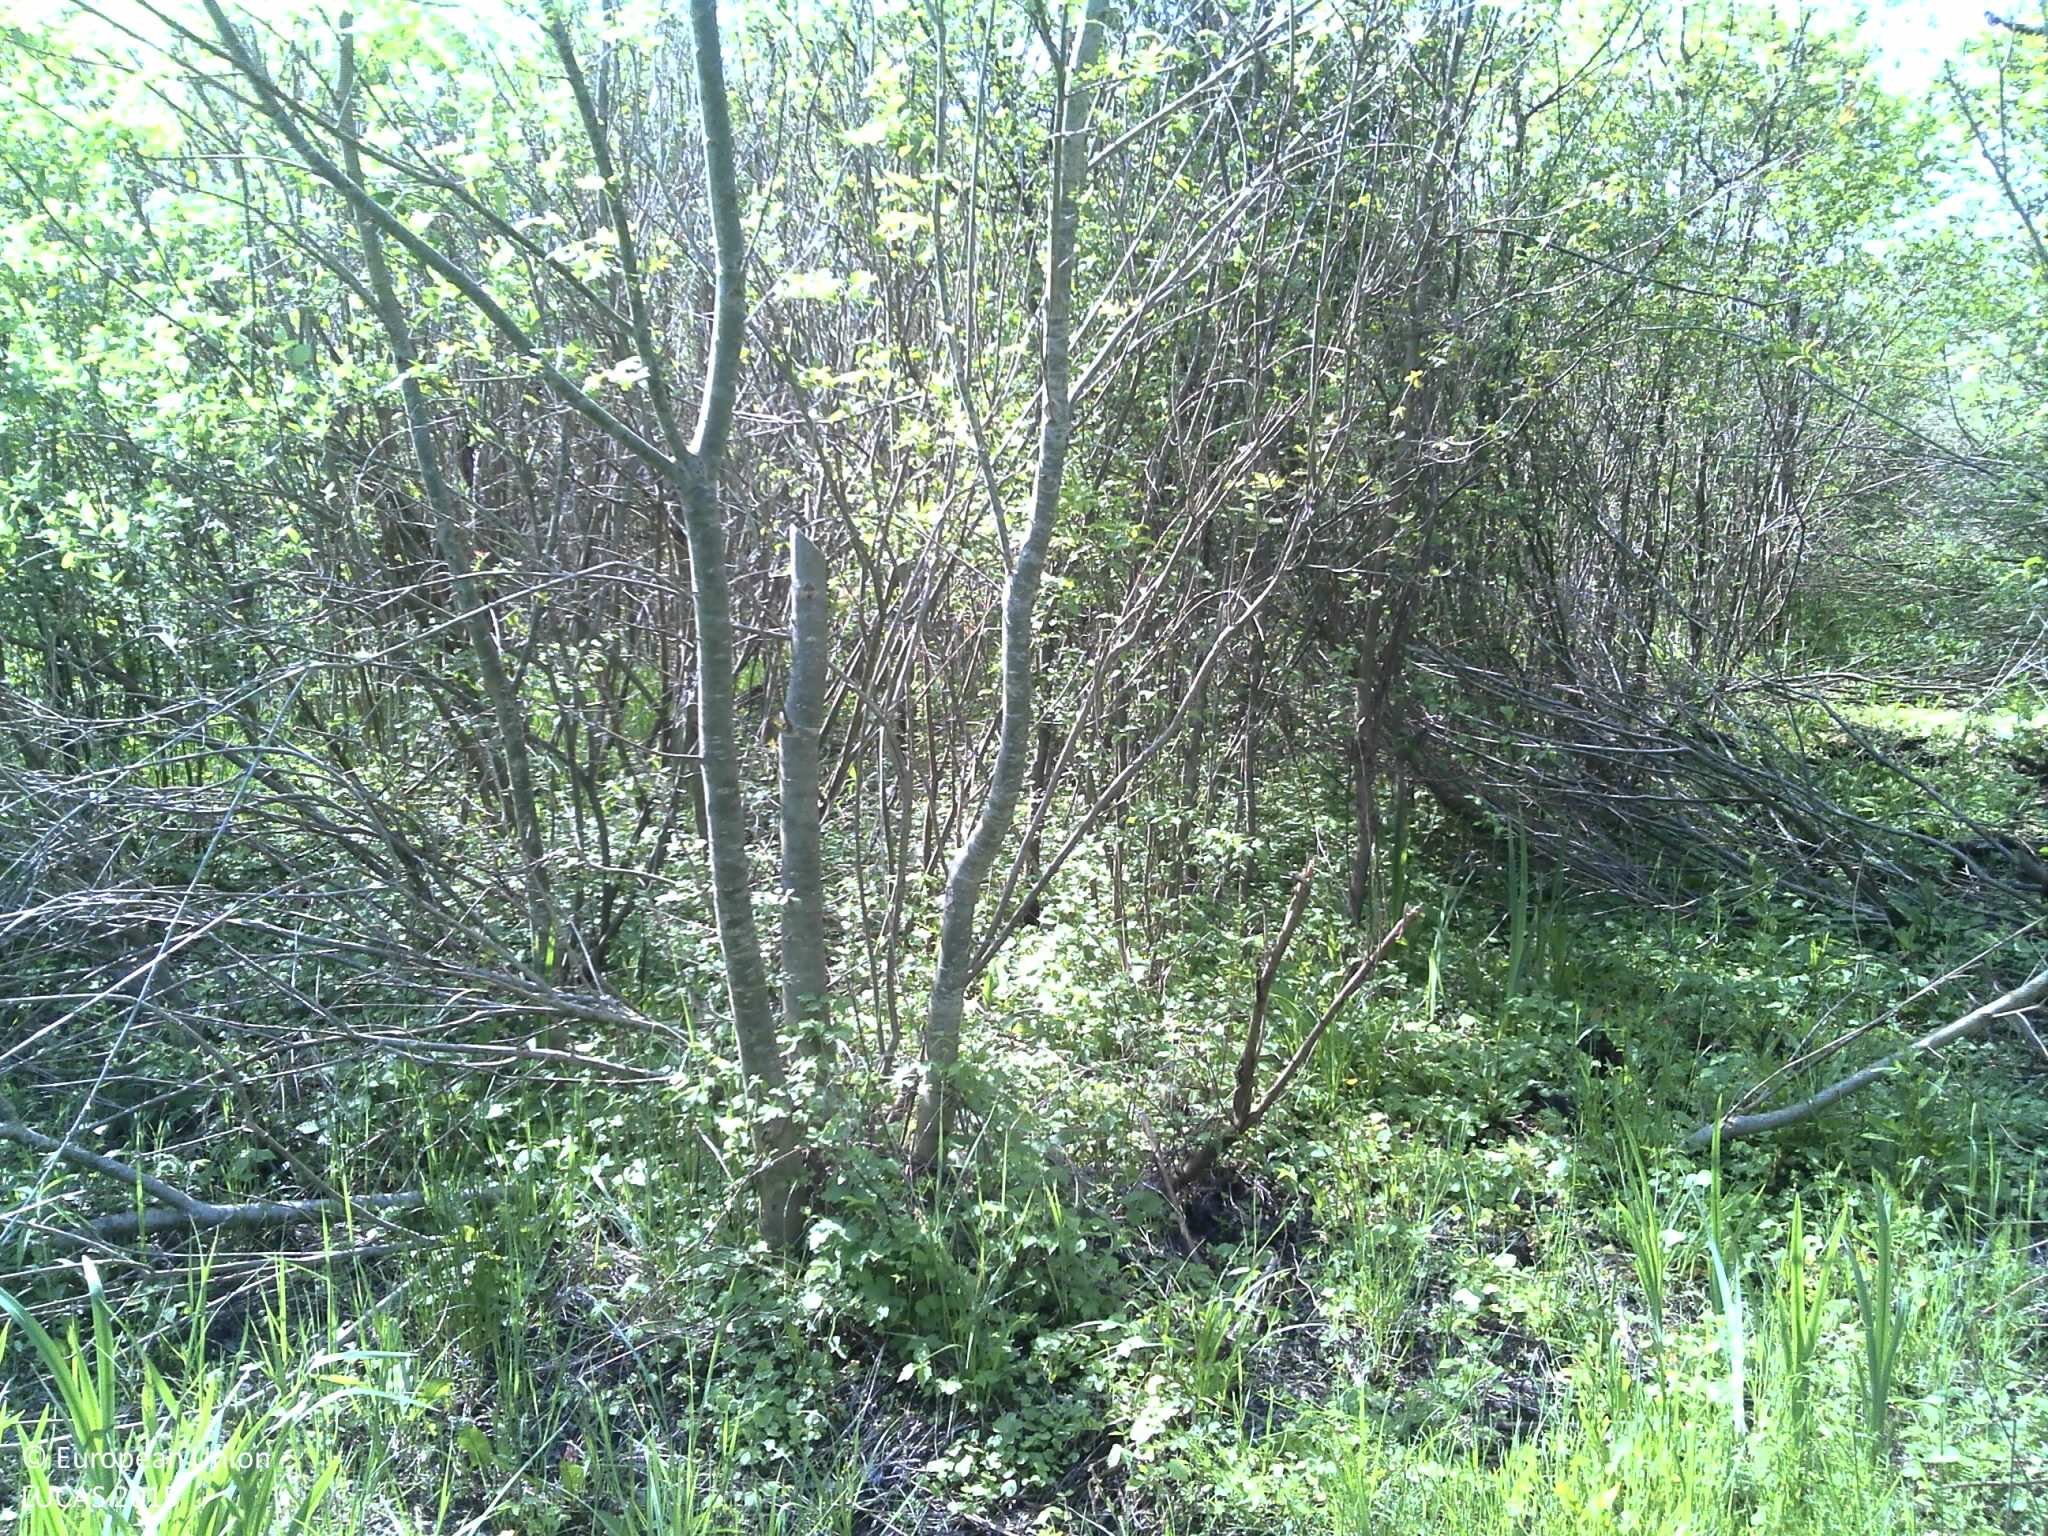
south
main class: Woodland
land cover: Broadleaved woodland
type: mesophytic deciduous forest
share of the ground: > 75 %
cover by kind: broadleaved forest trees 80 %, herbaceous plants 20 %
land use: Forestry
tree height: > 5 m
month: May
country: HR
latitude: 45.2177
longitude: 18.4732
